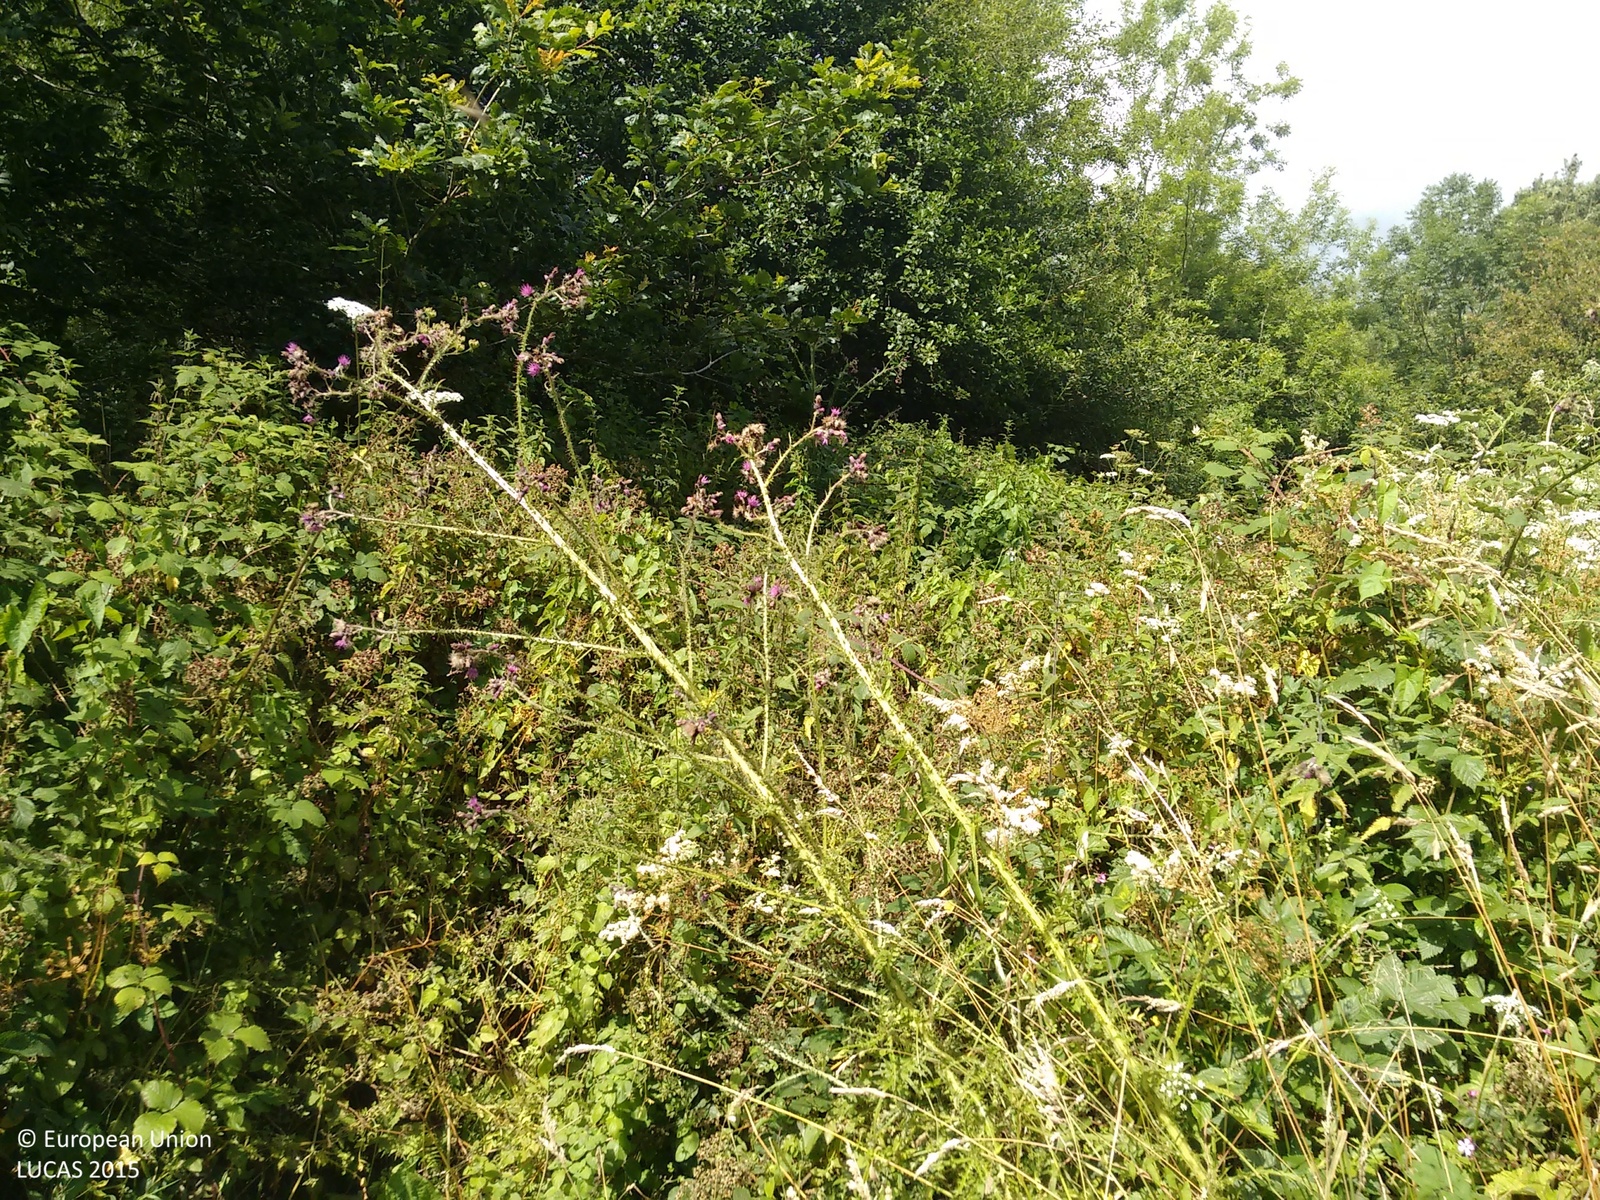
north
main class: Shrubland
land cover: Shrubland without tree cover
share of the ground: > 75 %
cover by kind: shrubs 80 %, herbaceous plants 20 %
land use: Semi-natural and natural areas not in use
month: August
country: GB
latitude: 50.3631
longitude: -3.9389
